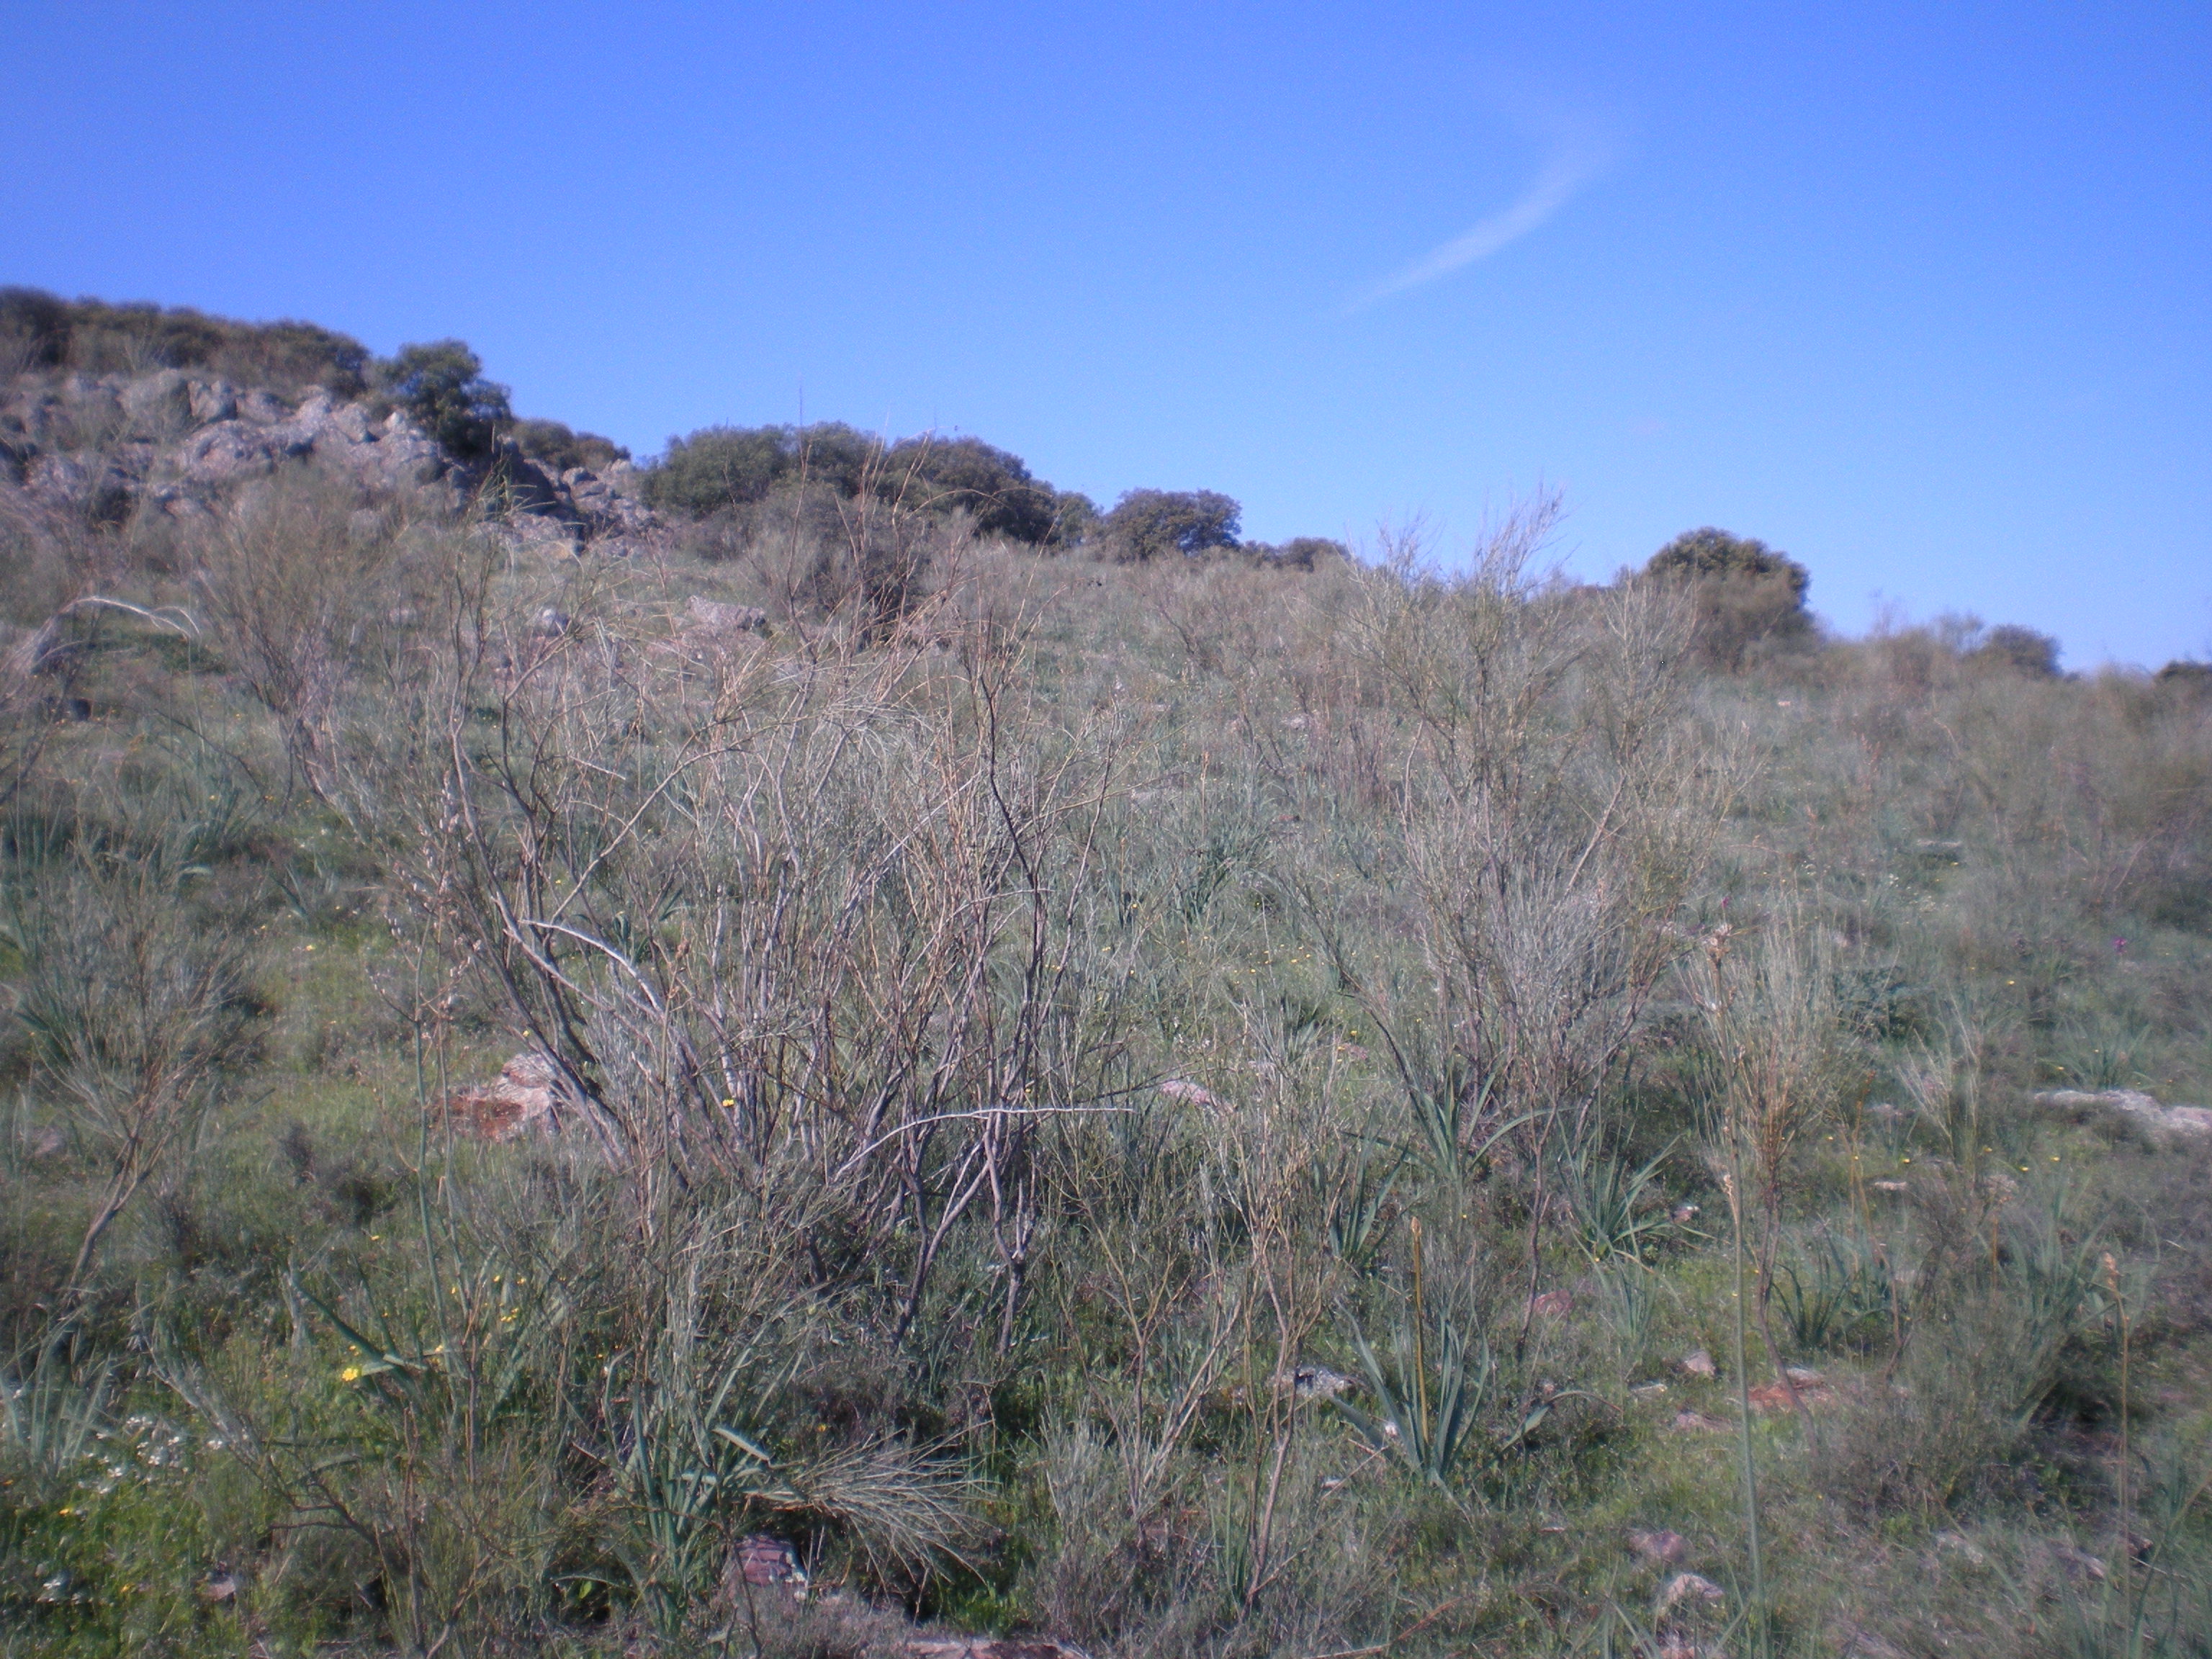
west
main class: Shrubland
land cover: Shrubland with sparse tree cover
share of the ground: 10 - 25 %
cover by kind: herbaceous plants 75 %, shrubs 20 %, broadleaved forest trees 5 %
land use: Agriculture (excluding fallow land and kitchen gardens)
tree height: < 5 m
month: April
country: ES
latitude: 38.9202
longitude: -3.5441
